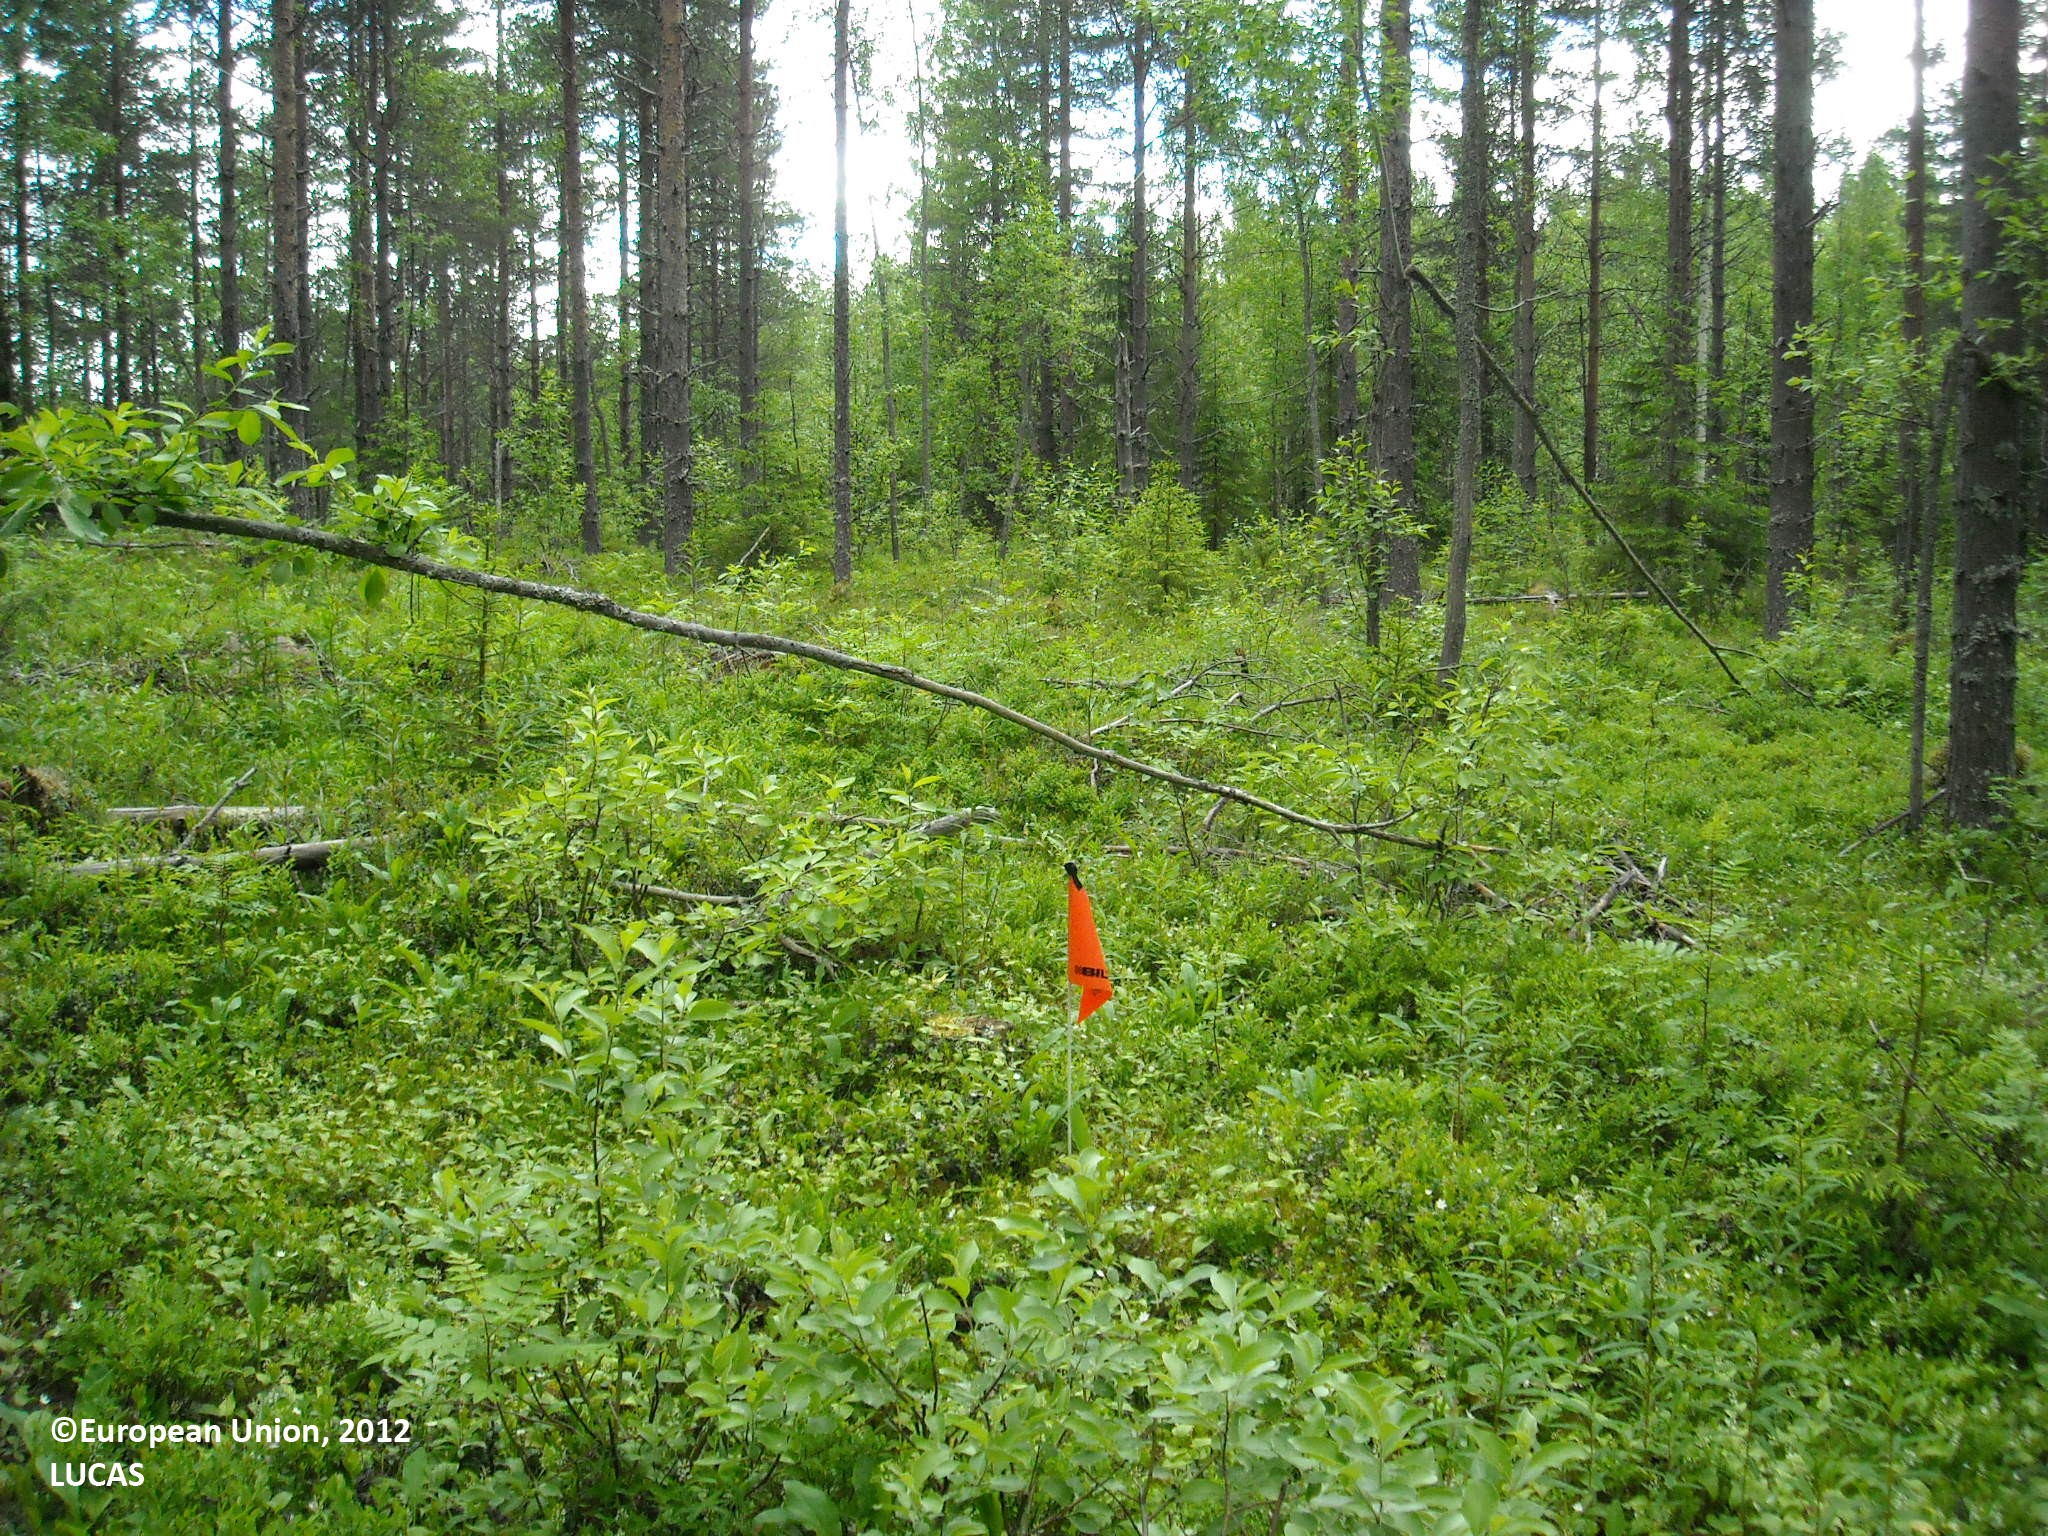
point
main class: Woodland
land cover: Pine dominated coniferous woodland
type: boreal forest
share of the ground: 25 - 50 %
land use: Forestry
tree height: > 5 m
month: June
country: FI
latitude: 64.7281
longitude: 27.8920
